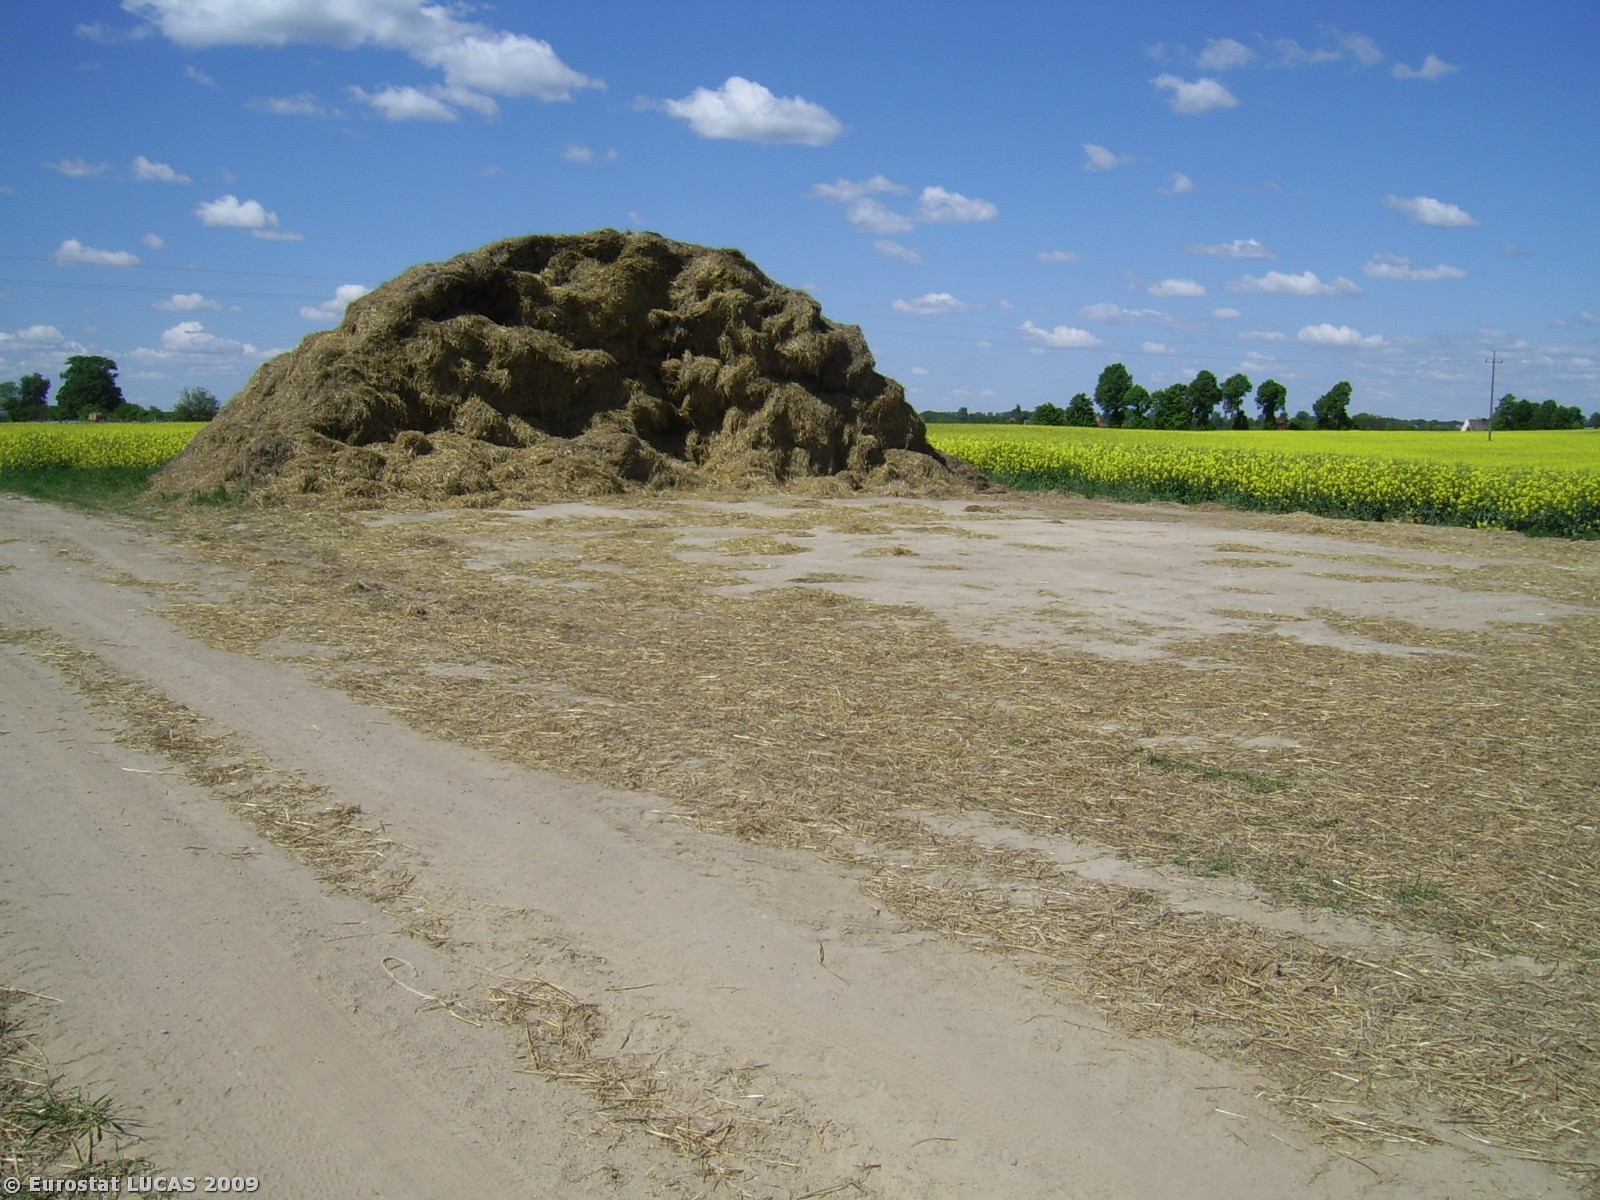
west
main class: Cropland
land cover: Common wheat
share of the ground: > 75 %
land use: Agriculture (excluding fallow land and kitchen gardens)
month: May
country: PL
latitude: 52.5313
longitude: 17.8718
